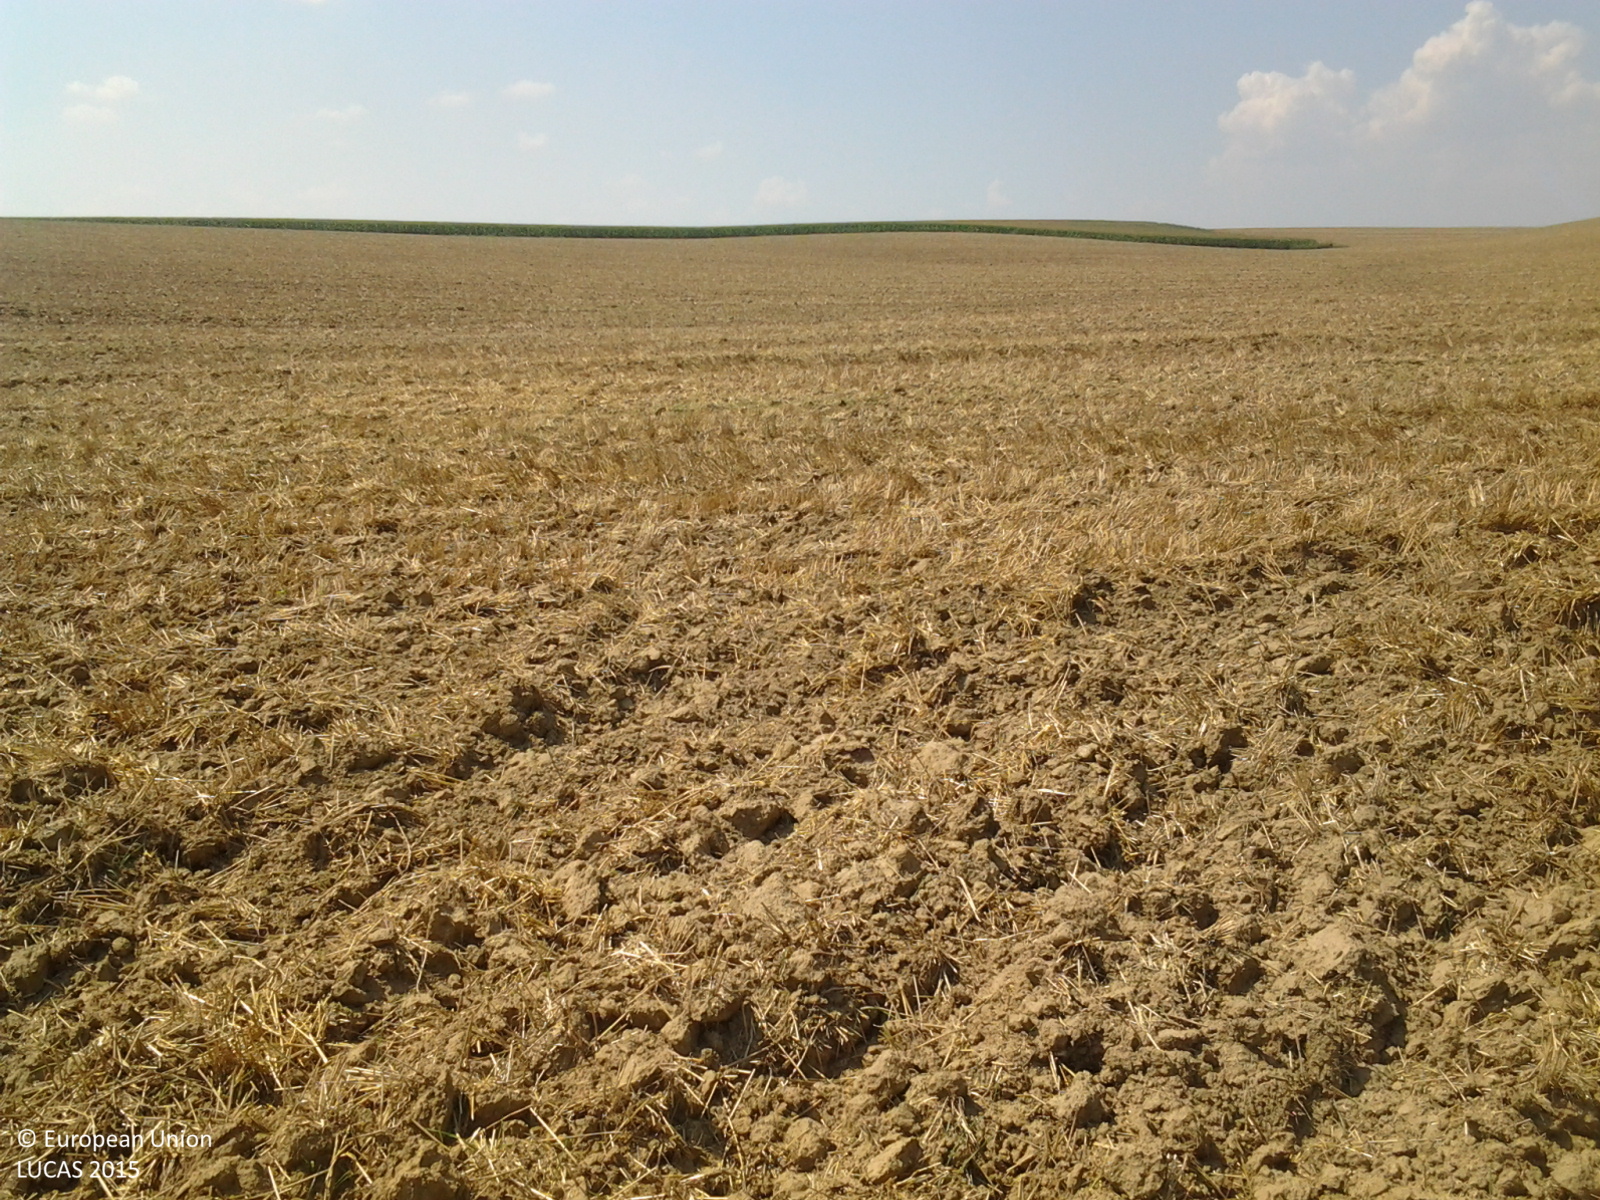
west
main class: Cropland
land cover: Triticale
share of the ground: < 10 %
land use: Agriculture (excluding fallow land and kitchen gardens)
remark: Harvested field
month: August
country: HU
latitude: 46.4505
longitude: 18.2231
